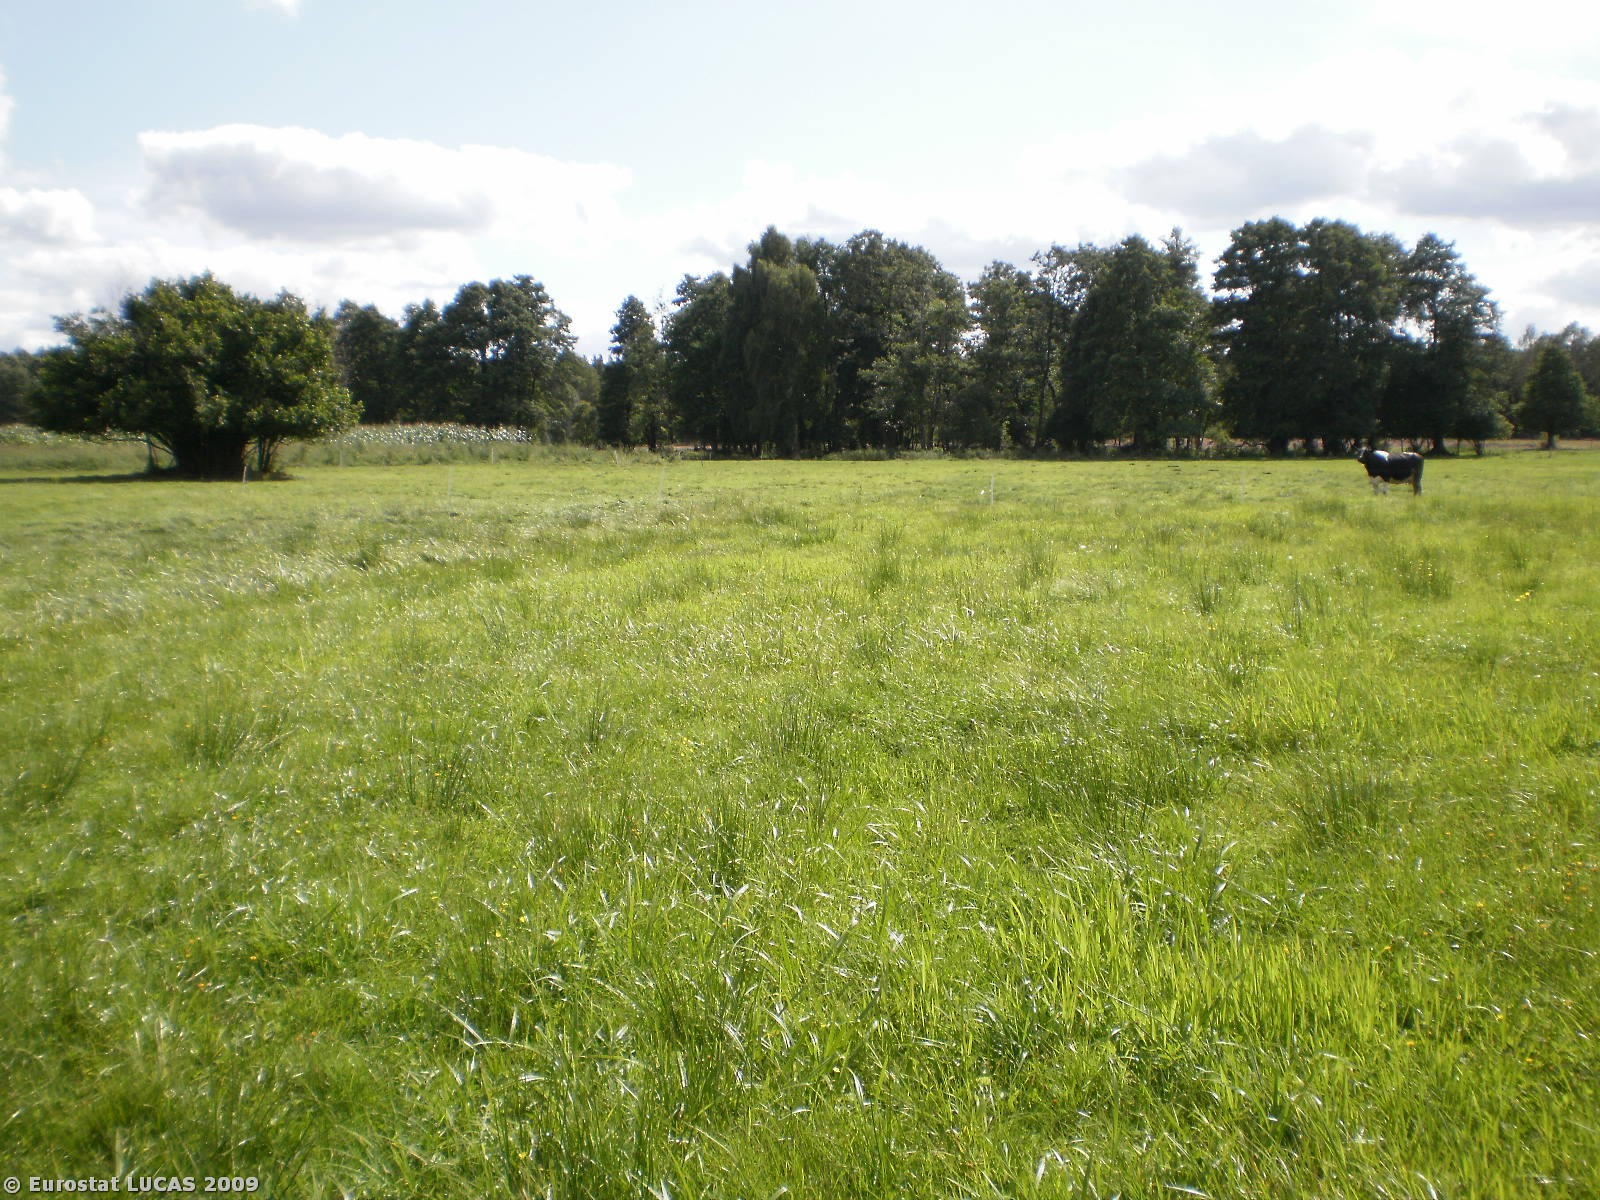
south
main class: Grassland
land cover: Grassland without tree/shrub cover
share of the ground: > 75 %
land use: Agriculture (excluding fallow land and kitchen gardens)
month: August
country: PL
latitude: 52.8203
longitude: 21.8227
